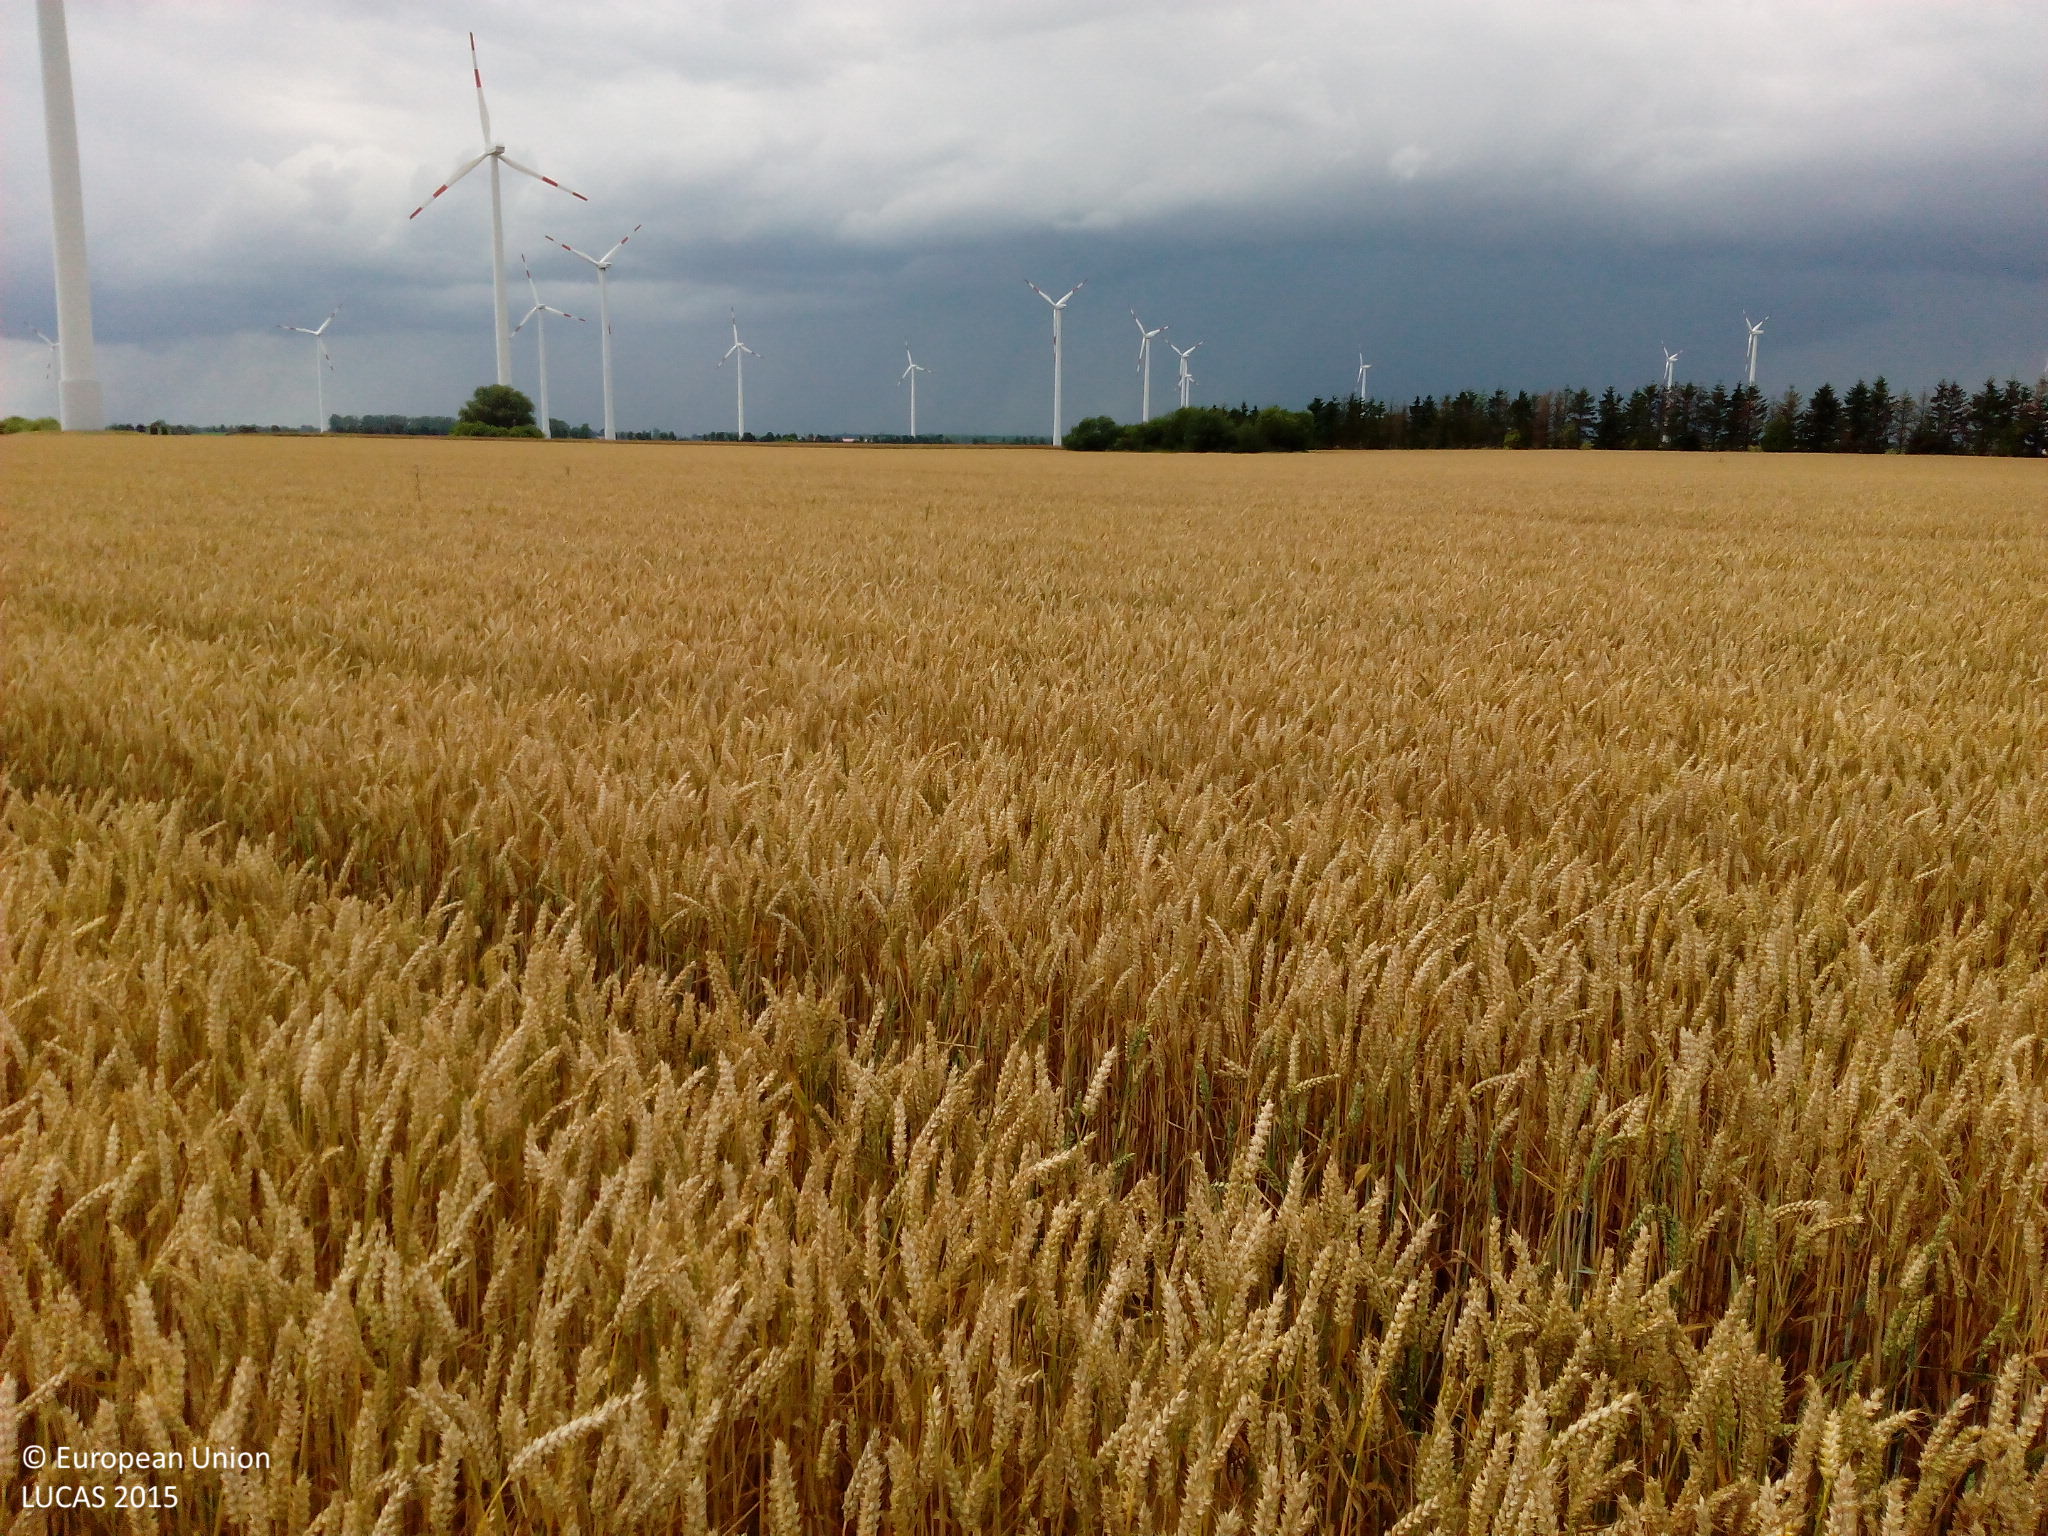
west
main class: Cropland
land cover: Common wheat
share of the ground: > 75 %
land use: Agriculture (excluding fallow land and kitchen gardens)
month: July
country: DE
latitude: 54.2720
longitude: 12.6556
